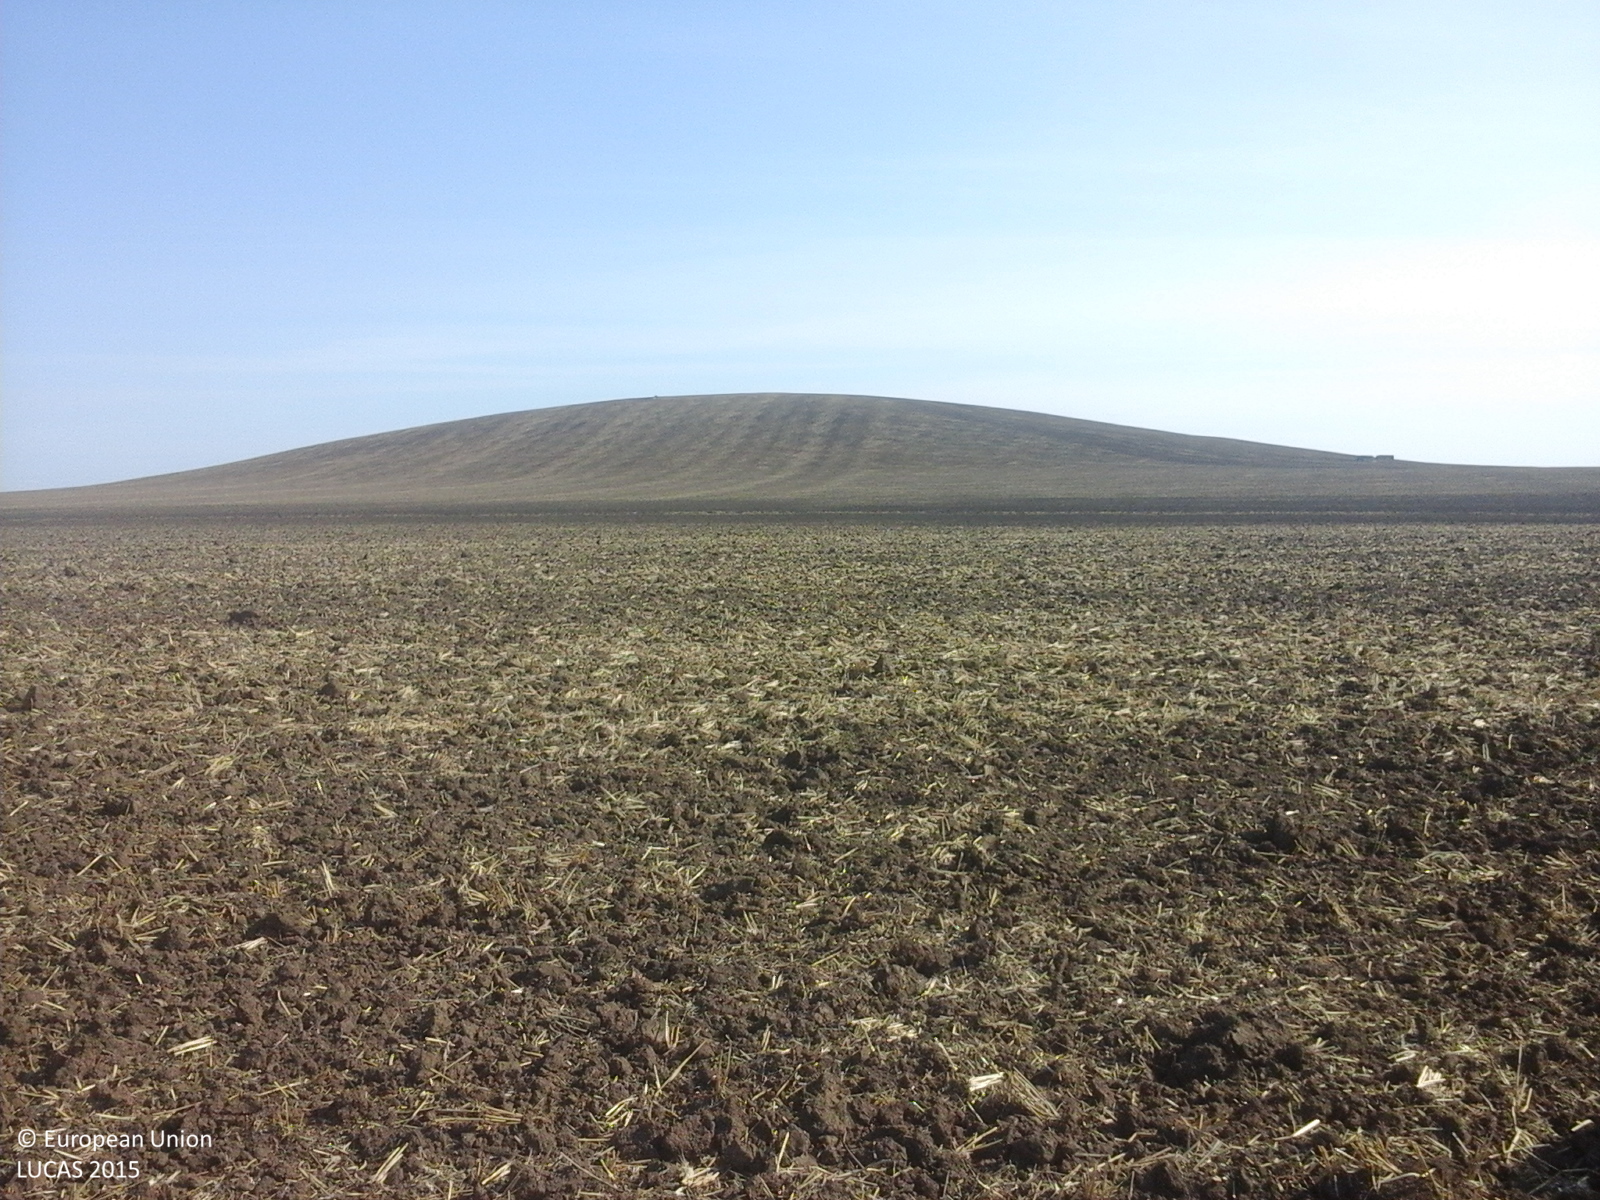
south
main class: Cropland
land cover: Common wheat
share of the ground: < 10 %
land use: Agriculture (excluding fallow land and kitchen gardens)
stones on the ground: < 10 %
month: August
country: RO
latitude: 45.3928
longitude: 21.4117
